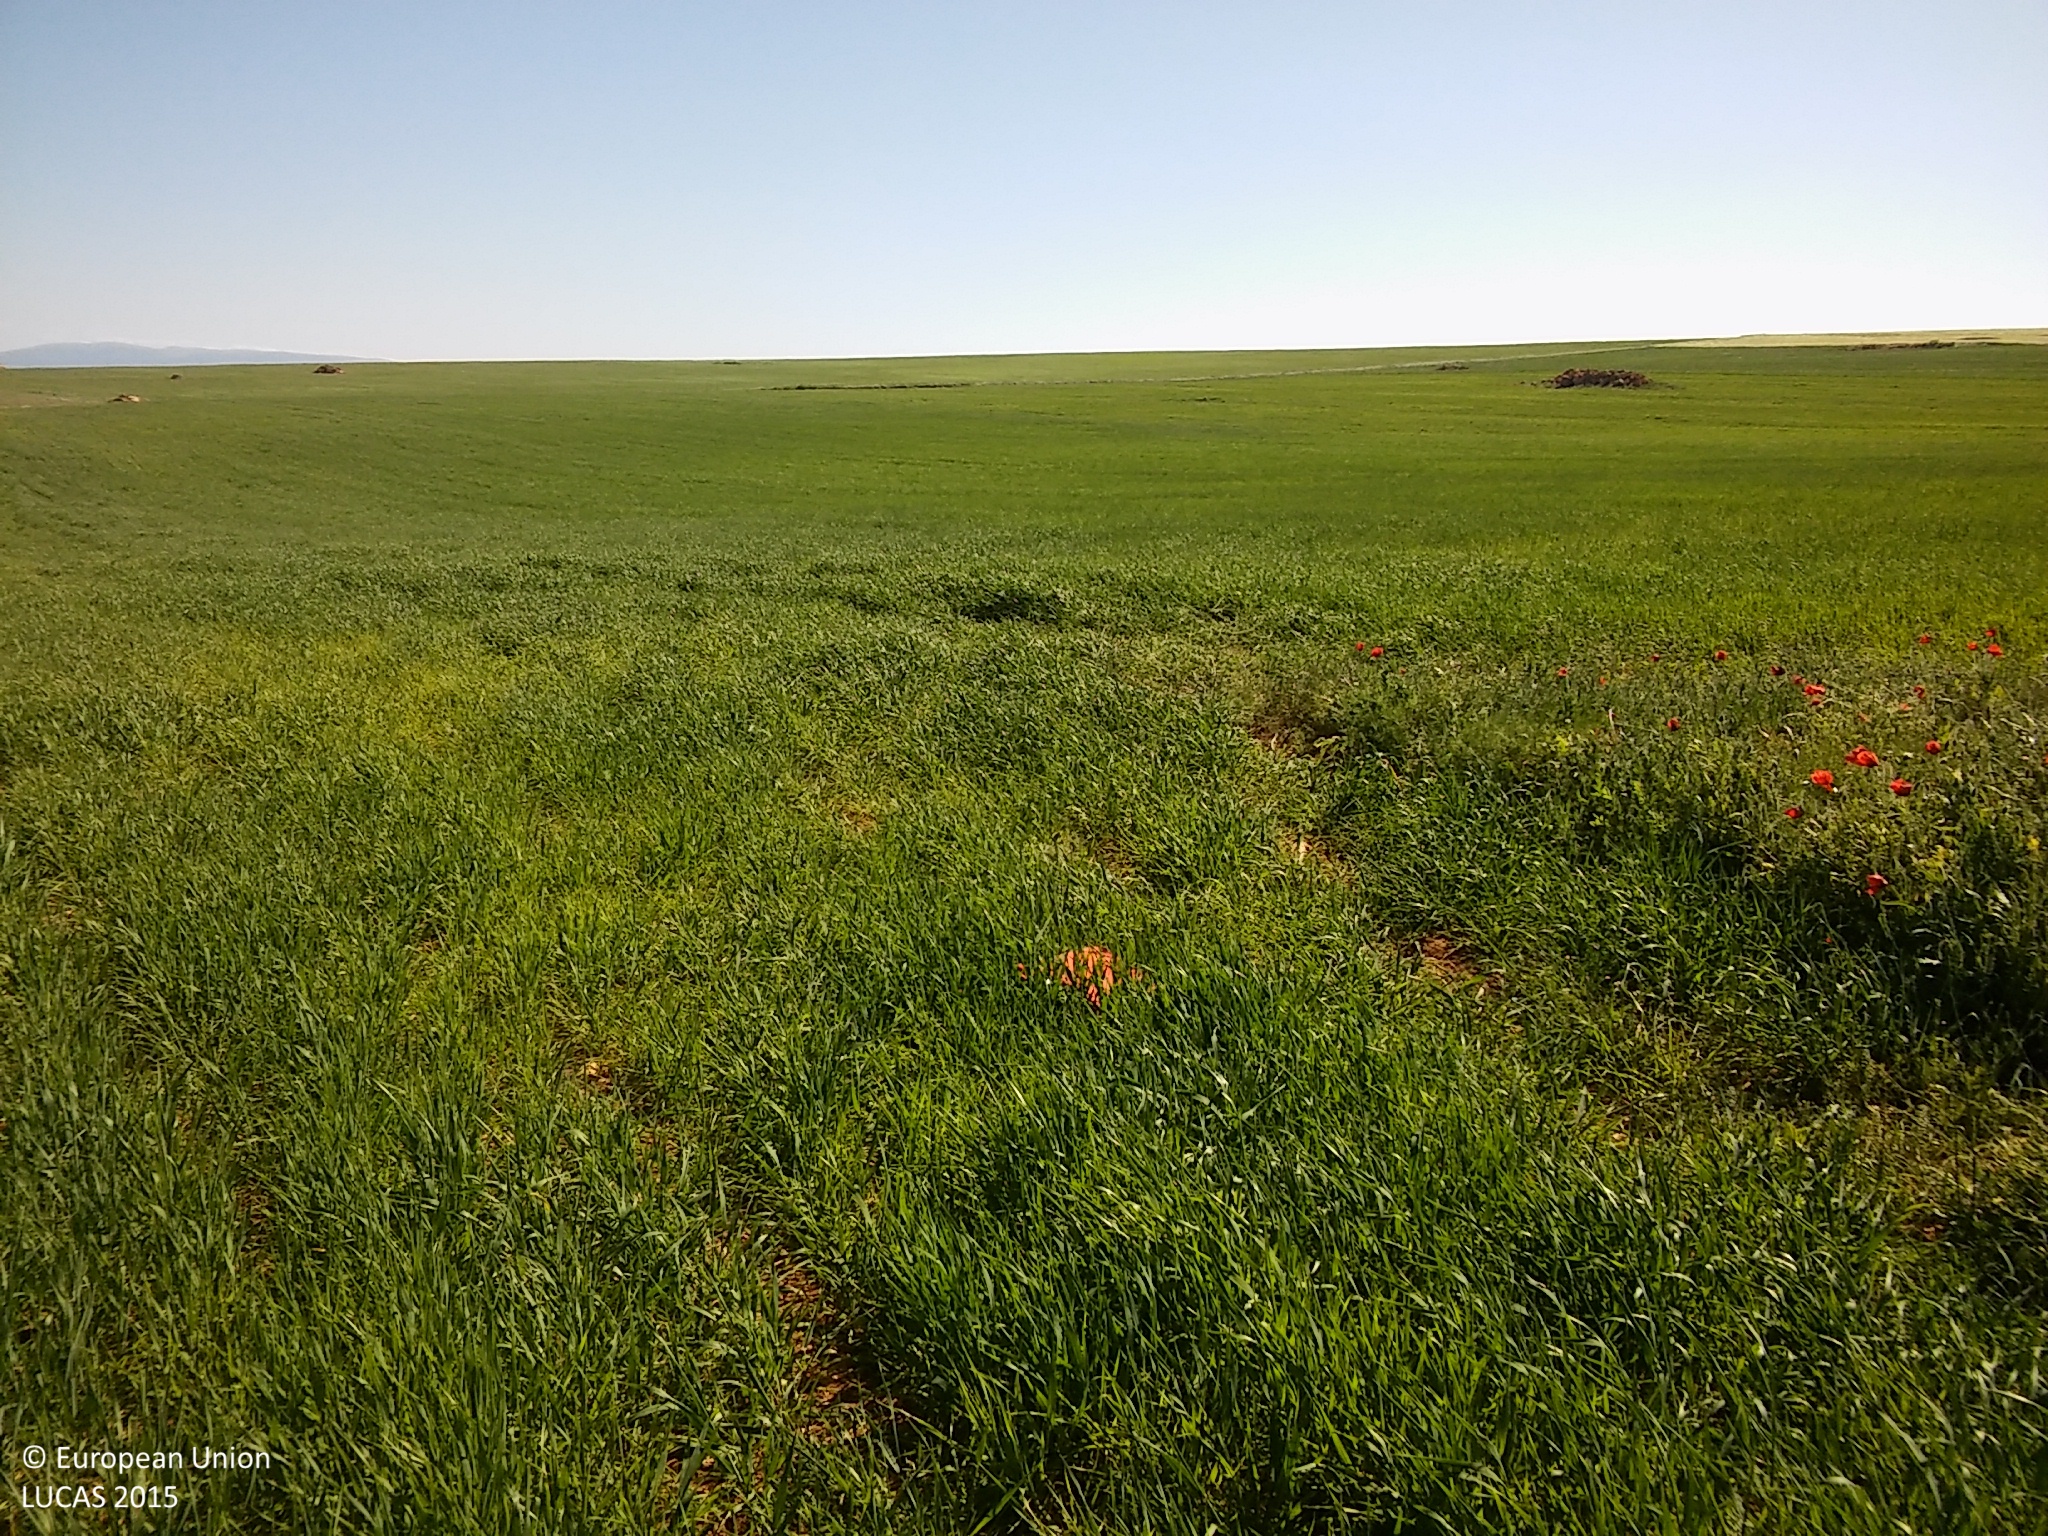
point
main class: Cropland
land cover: Barley
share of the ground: > 75 %
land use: Agriculture (excluding fallow land and kitchen gardens)
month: May
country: ES
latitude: 41.3830
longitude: -3.7420
